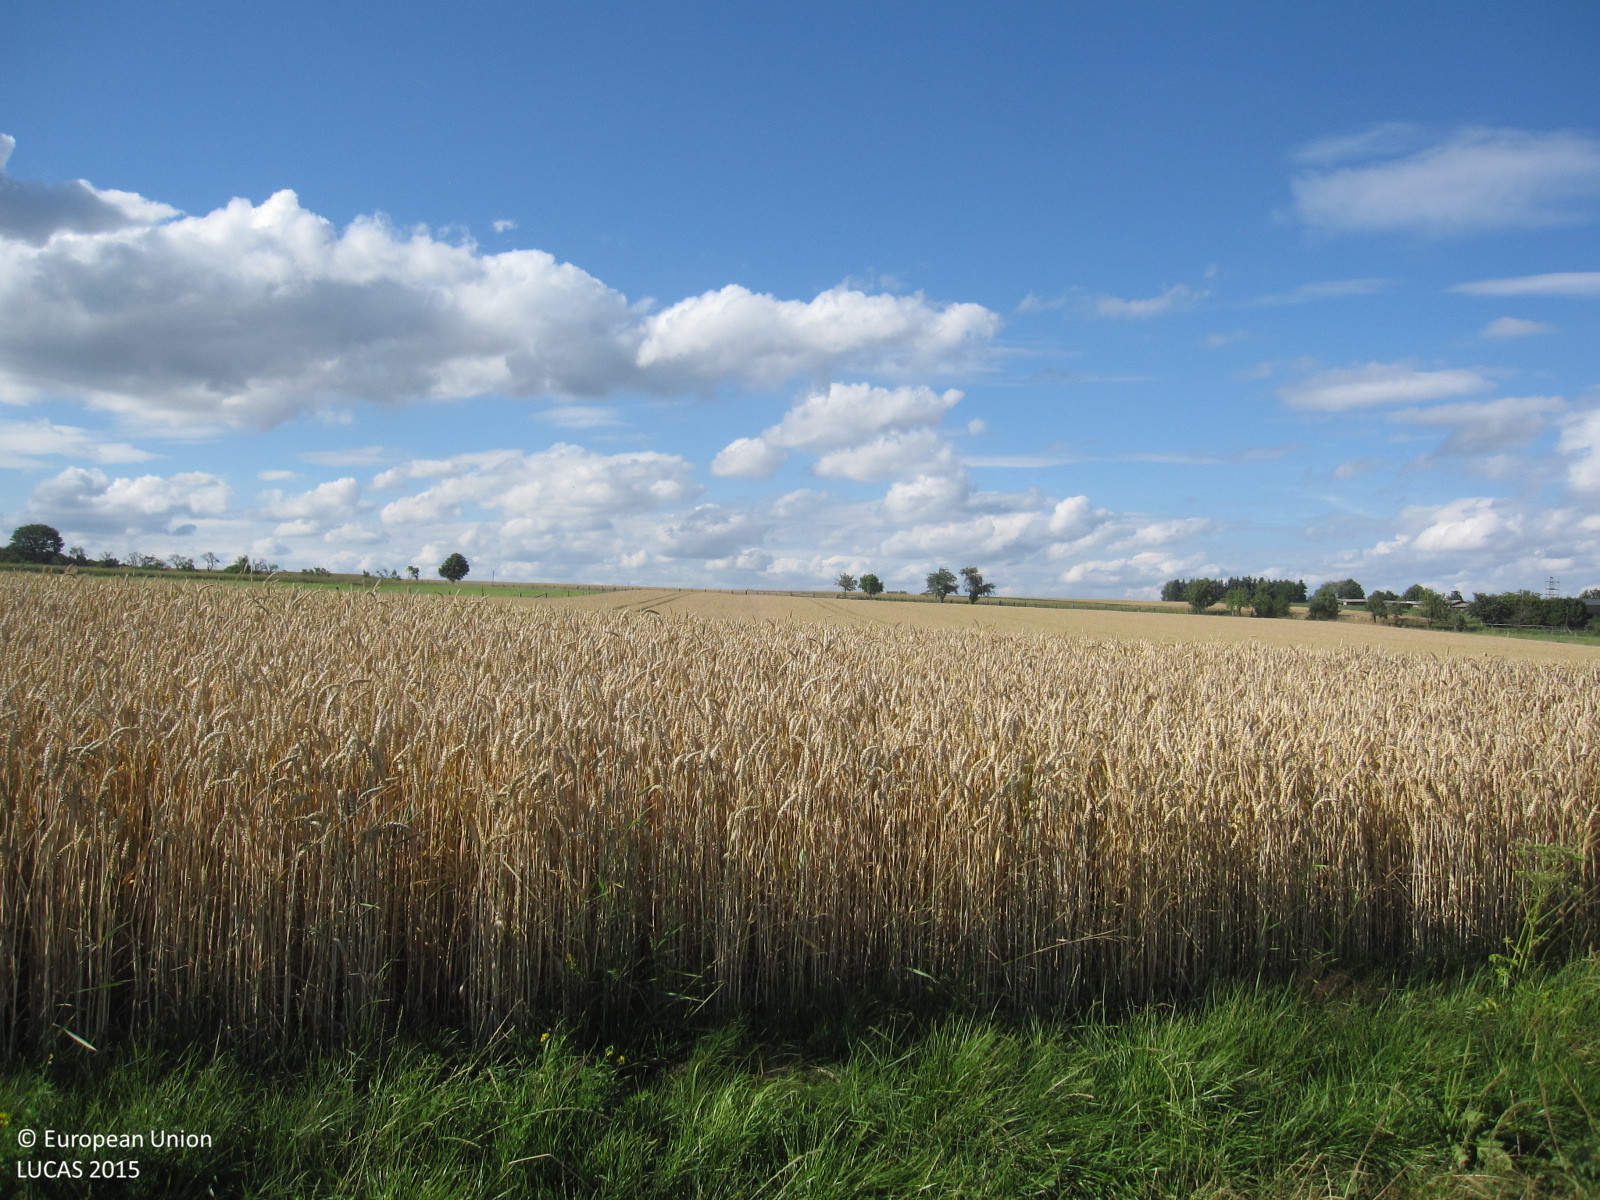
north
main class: Cropland
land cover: Common wheat
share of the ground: > 75 %
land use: Agriculture (excluding fallow land and kitchen gardens)
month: July
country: DE
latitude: 50.9570
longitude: 12.0640
